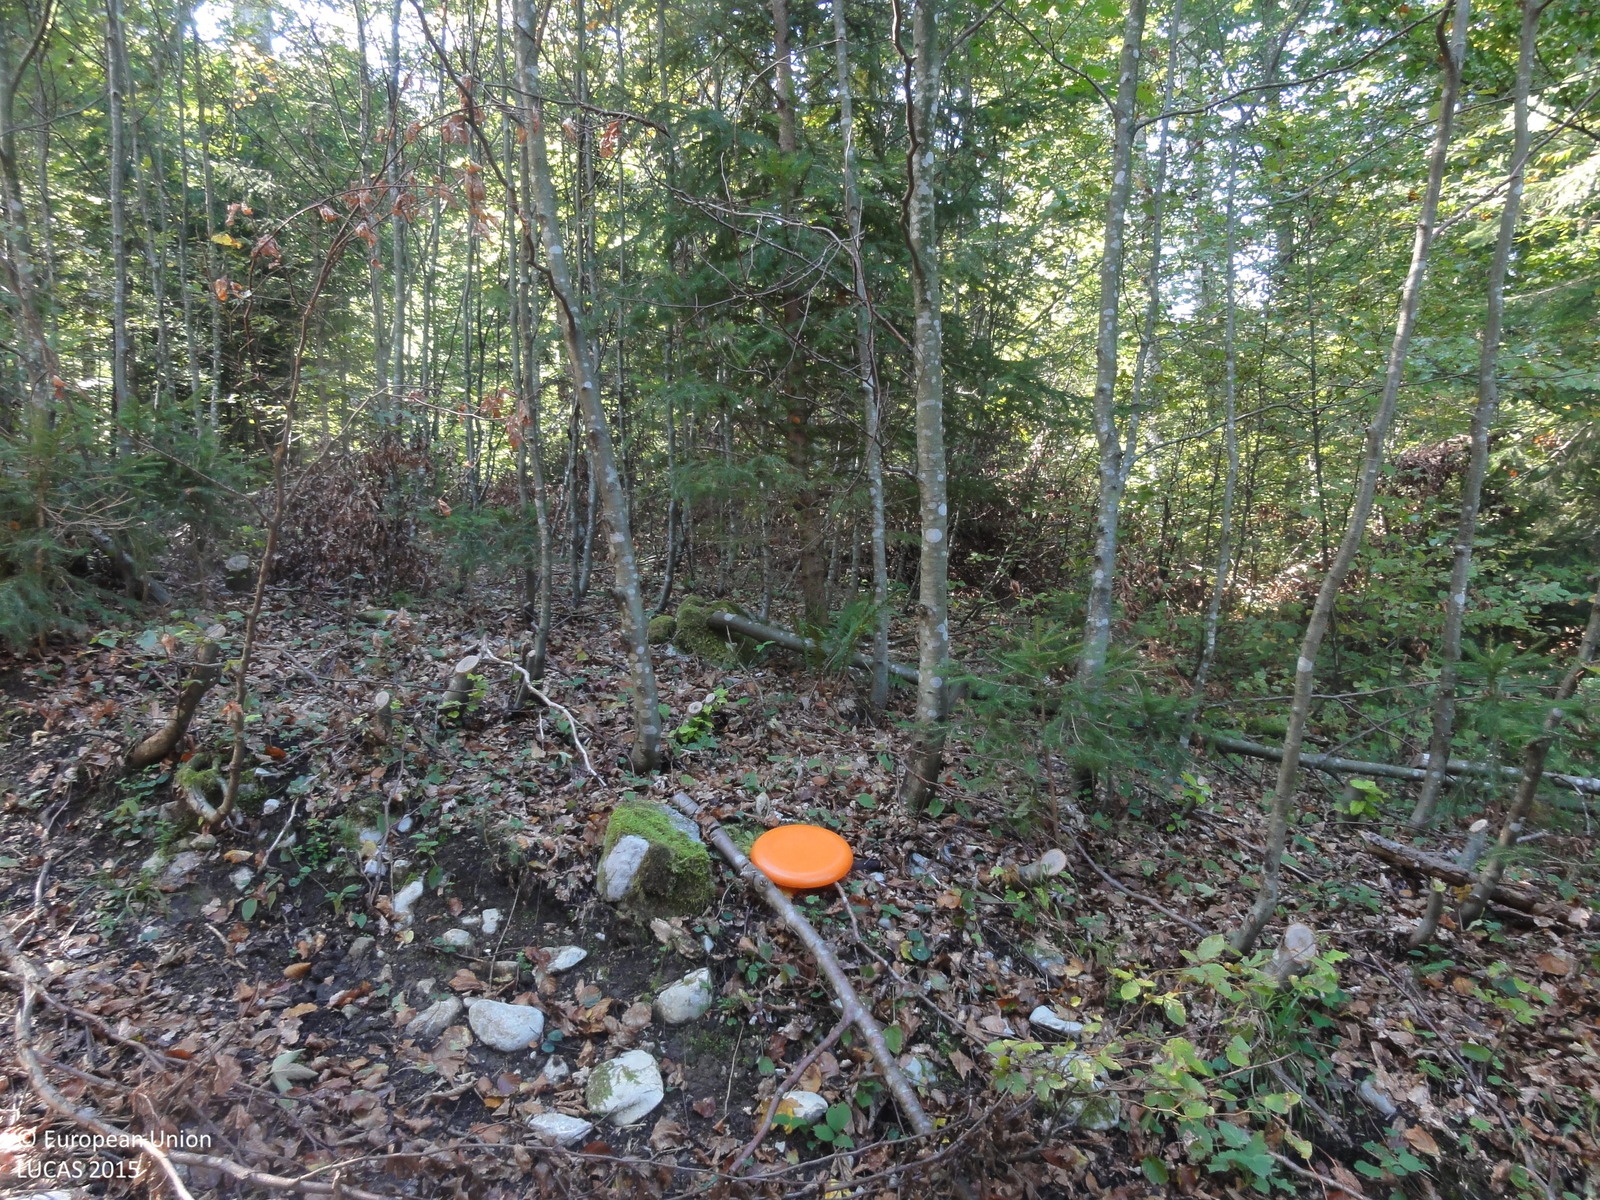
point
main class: Woodland
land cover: Spruce dominated mixed woodland
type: mountainous beech forest
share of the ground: > 75 %
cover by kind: broadleaved forest trees 50 %, coniferous forest trees 30 %, herbaceous plants 10 %, consolidated bare surface 5 %, unconsolidated bare surface 5 %
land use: Forestry
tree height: > 5 m
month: September
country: SI
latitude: 45.7112
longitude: 14.9931
